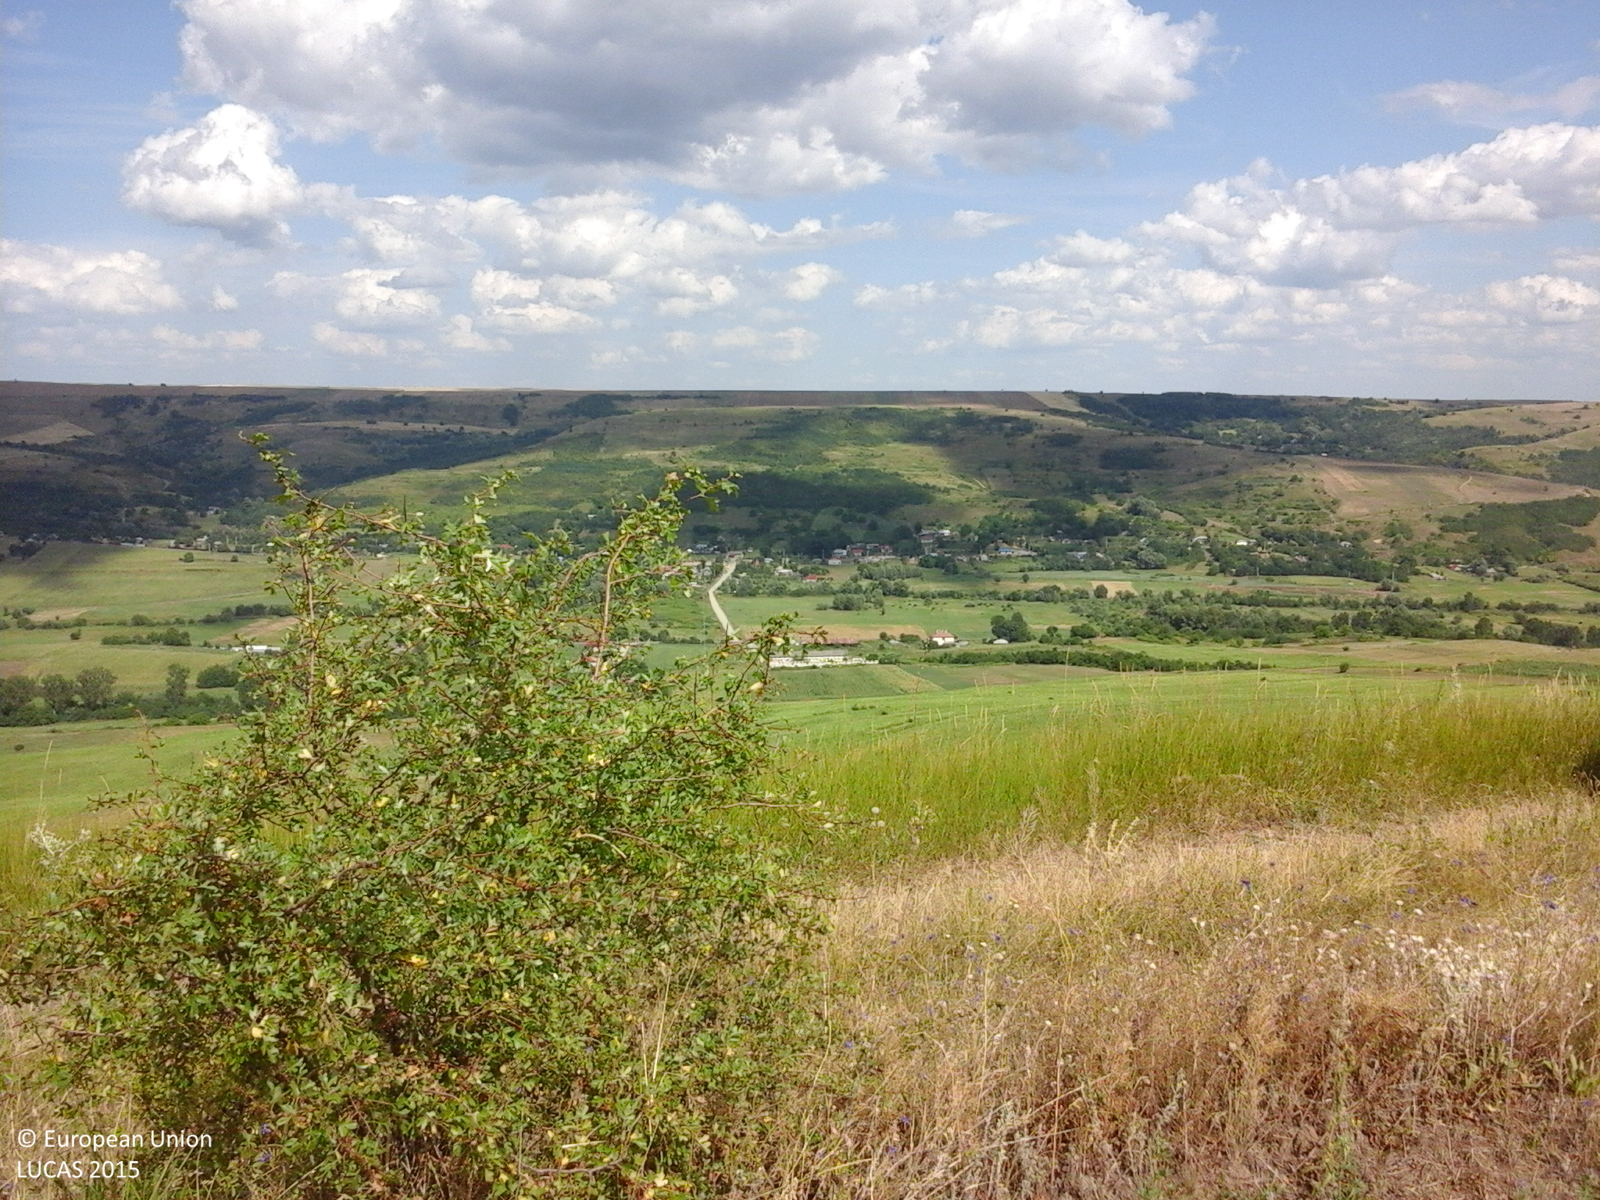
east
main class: Cropland
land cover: Lucerne
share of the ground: 25 - 50 %
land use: Agriculture (excluding fallow land and kitchen gardens)
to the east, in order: Lucerne; Single bushes/trees; Shruby margins; Tracks; Grassland without tree/shrub cover; Sunflower
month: July
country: RO
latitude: 46.3682
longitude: 27.3816
